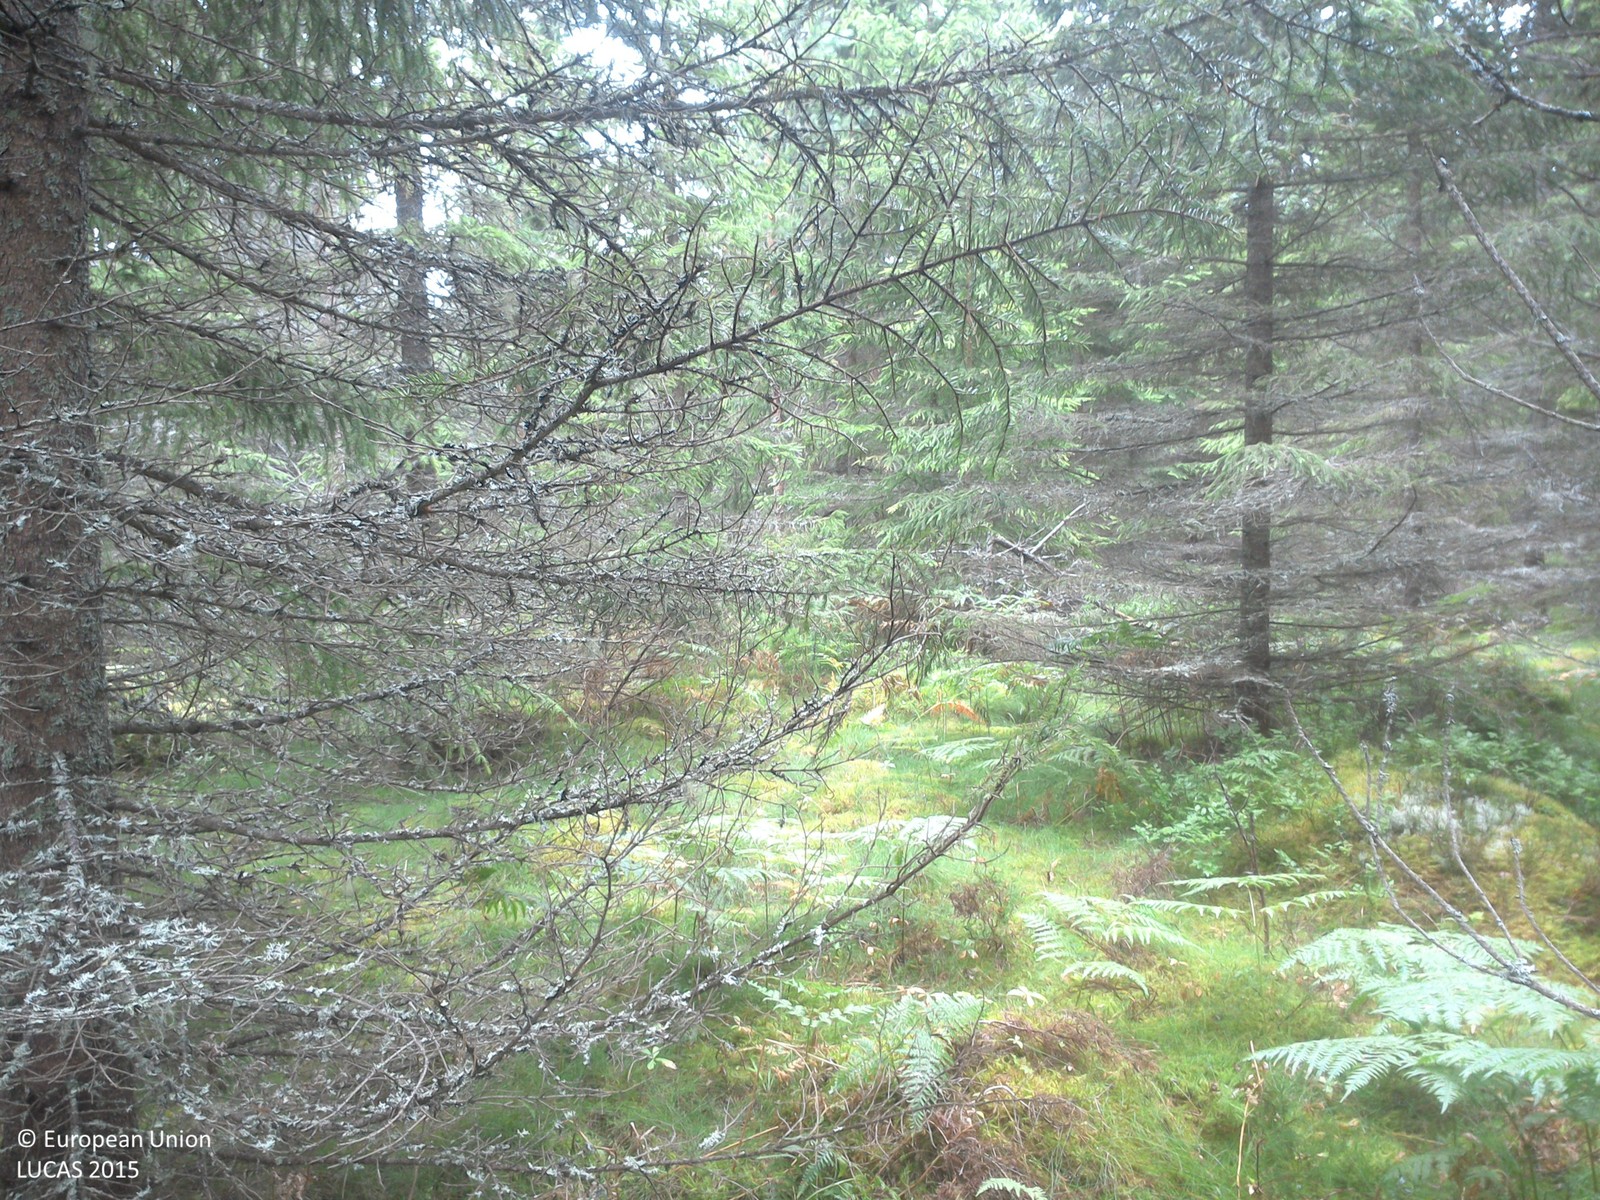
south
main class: Woodland
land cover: Spruce dominated coniferous woodland
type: boreal forest
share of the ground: > 75 %
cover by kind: coniferous forest trees 80 %, shrubs 10 %, lichens and mosses 10 %
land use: Forestry
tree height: > 5 m
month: August
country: SE
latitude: 57.7661
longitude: 15.4592
